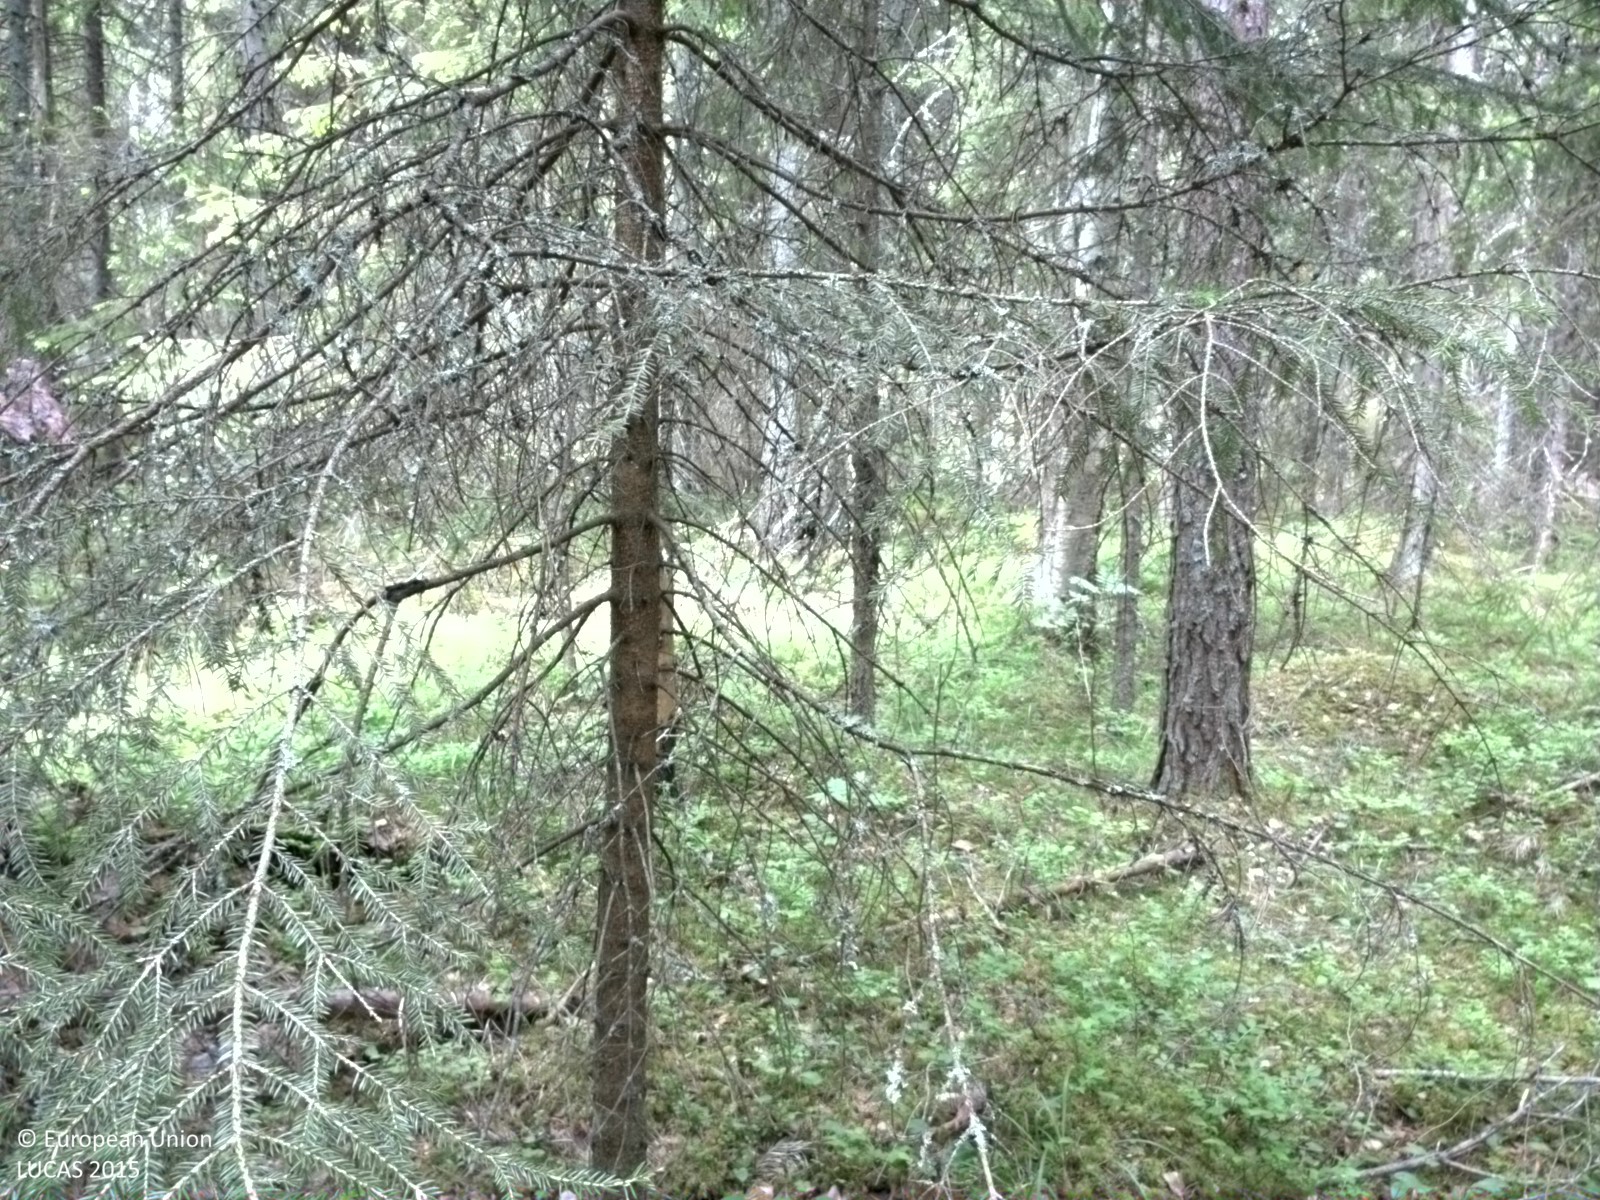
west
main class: Woodland
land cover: Spruce dominated coniferous woodland
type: boreal forest
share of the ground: > 75 %
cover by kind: coniferous forest trees 75 %, shrubs 10 %, lichens and mosses 10 %, broadleaved forest trees 5 %
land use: Forestry
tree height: > 5 m
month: June
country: SE
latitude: 60.2642
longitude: 17.2753
